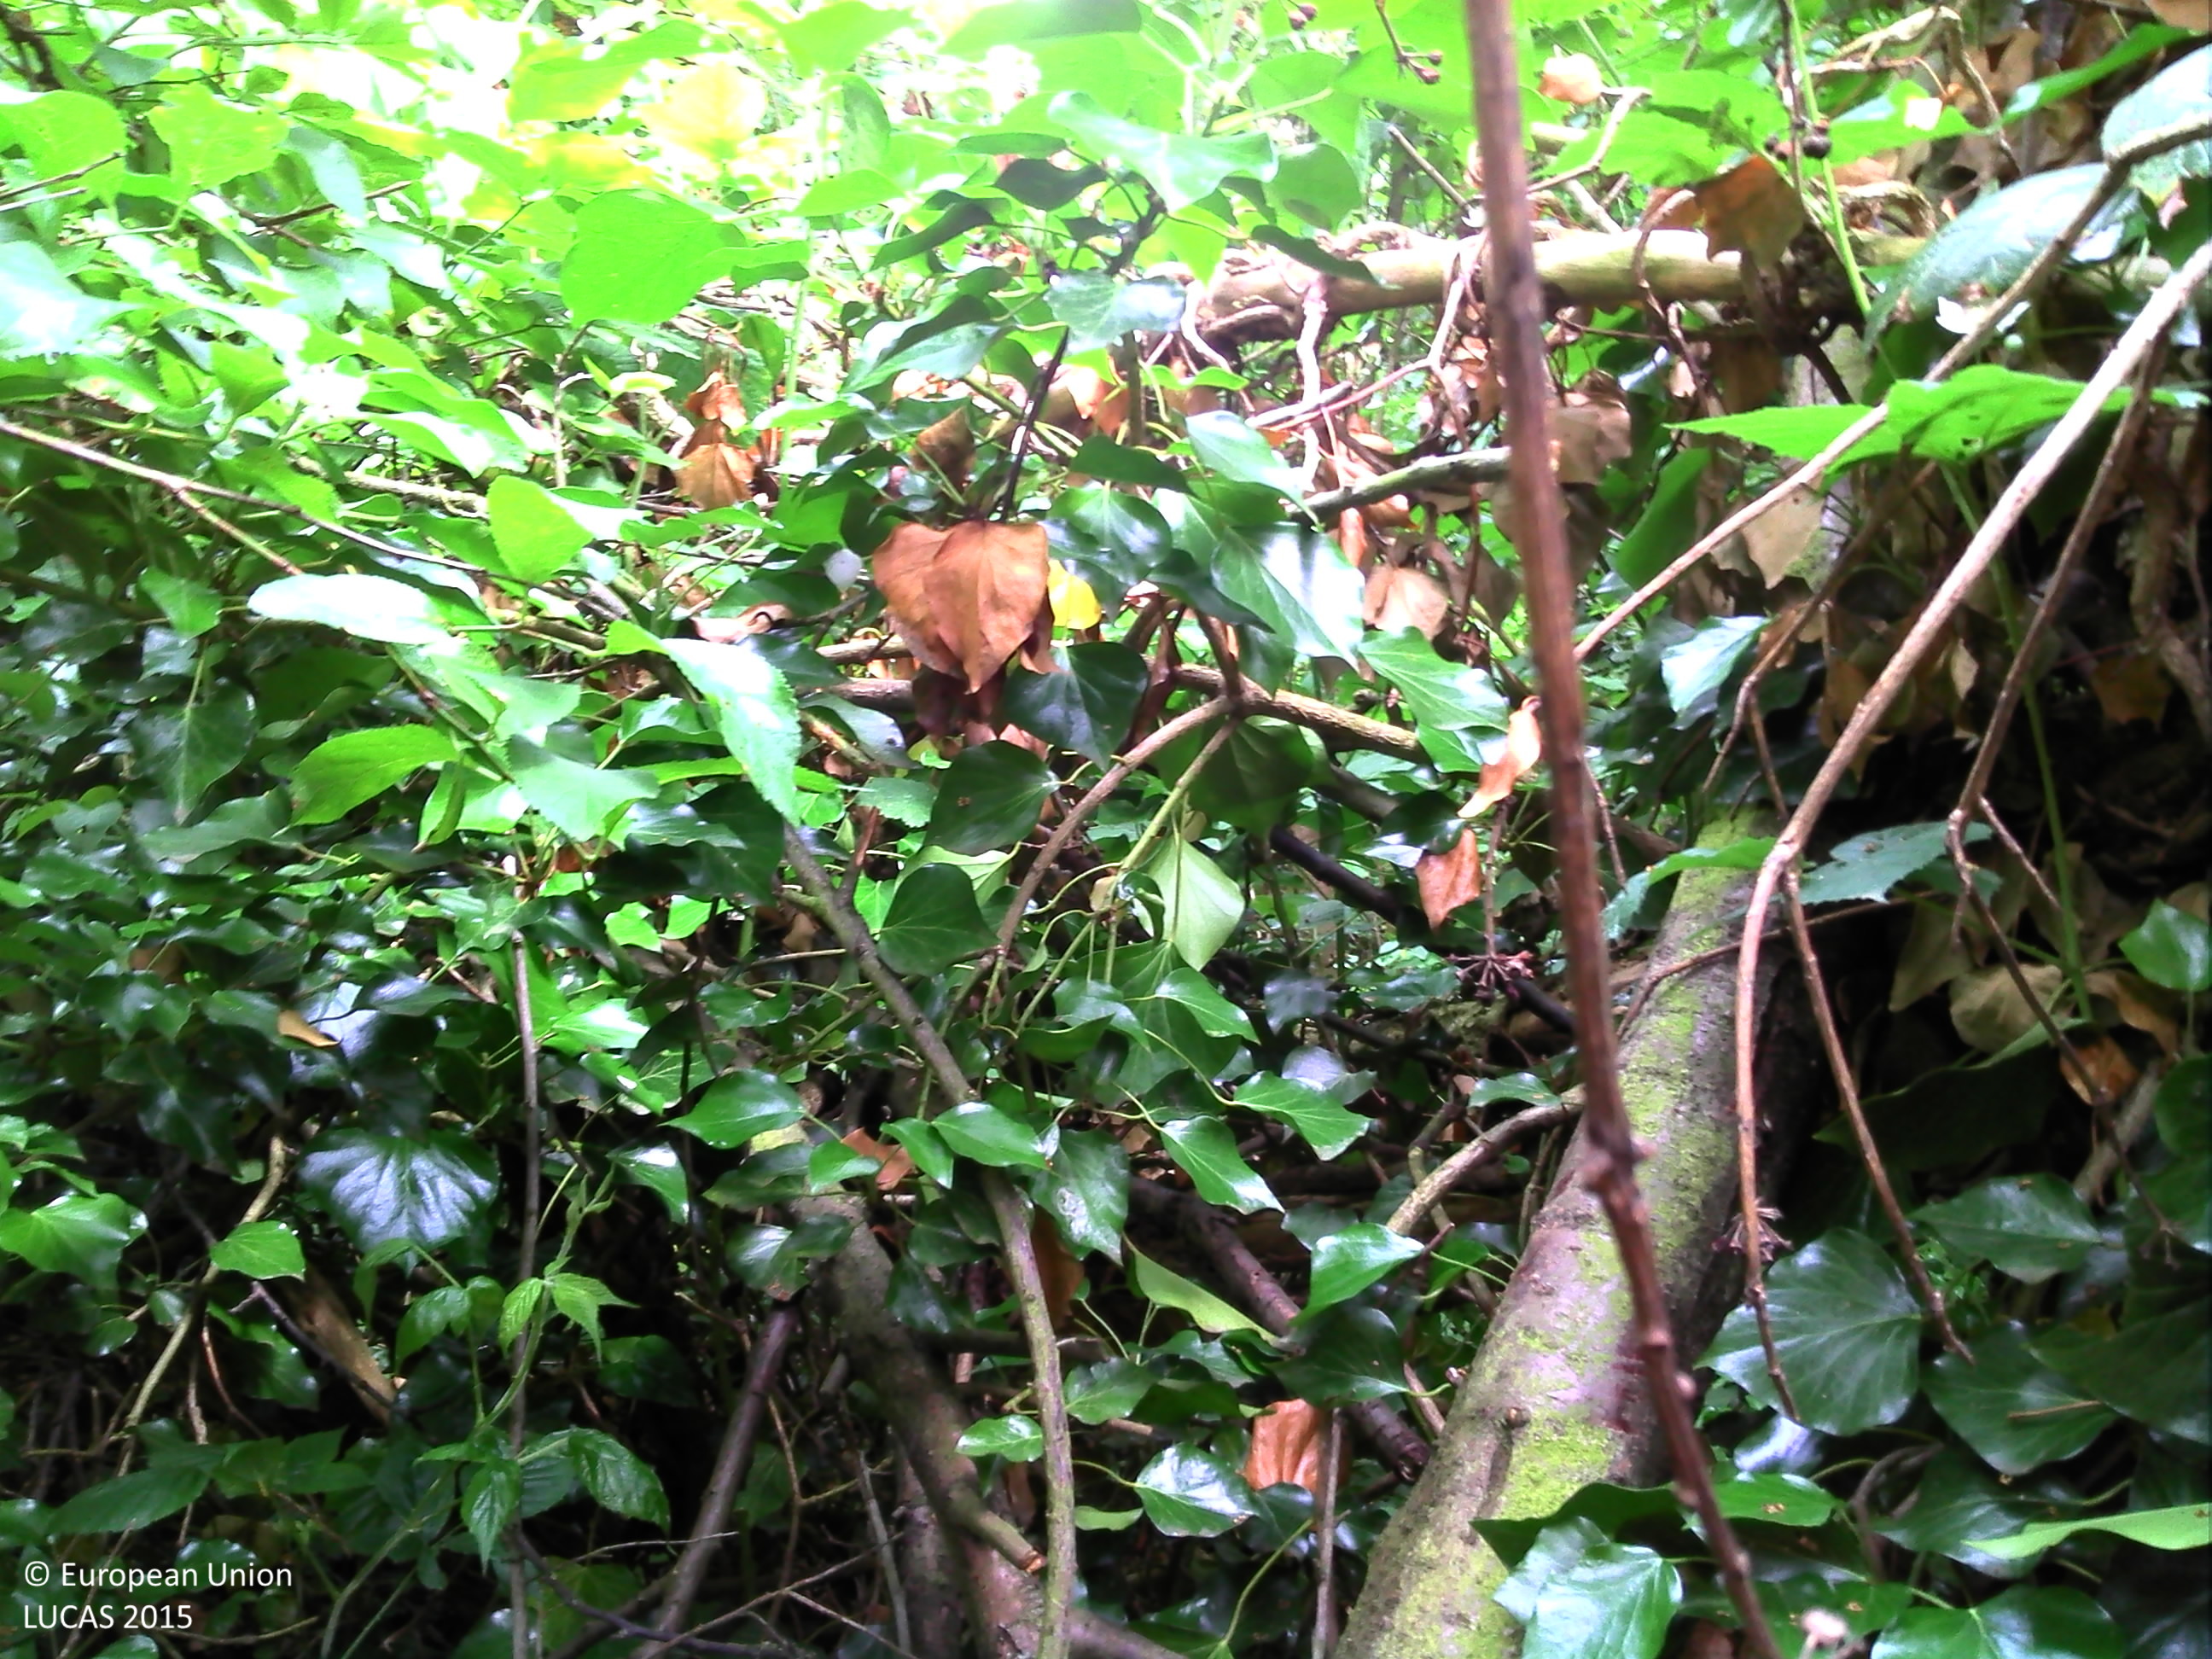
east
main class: Woodland
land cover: Broadleaved woodland
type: non-riverine alder, birch or aspen forest
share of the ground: > 75 %
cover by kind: broadleaved forest trees 60 %, herbaceous plants 40 %
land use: Semi-natural and natural areas not in use
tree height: > 5 m
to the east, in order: Broadleaved woodland; Grassland without tree/shrub cover; Other bare soil; Electric lines; Paved roads, cycling and walking lanes; Dry stone walls; Broadleaved woodland
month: June
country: BE
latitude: 50.6195
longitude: 5.5460
